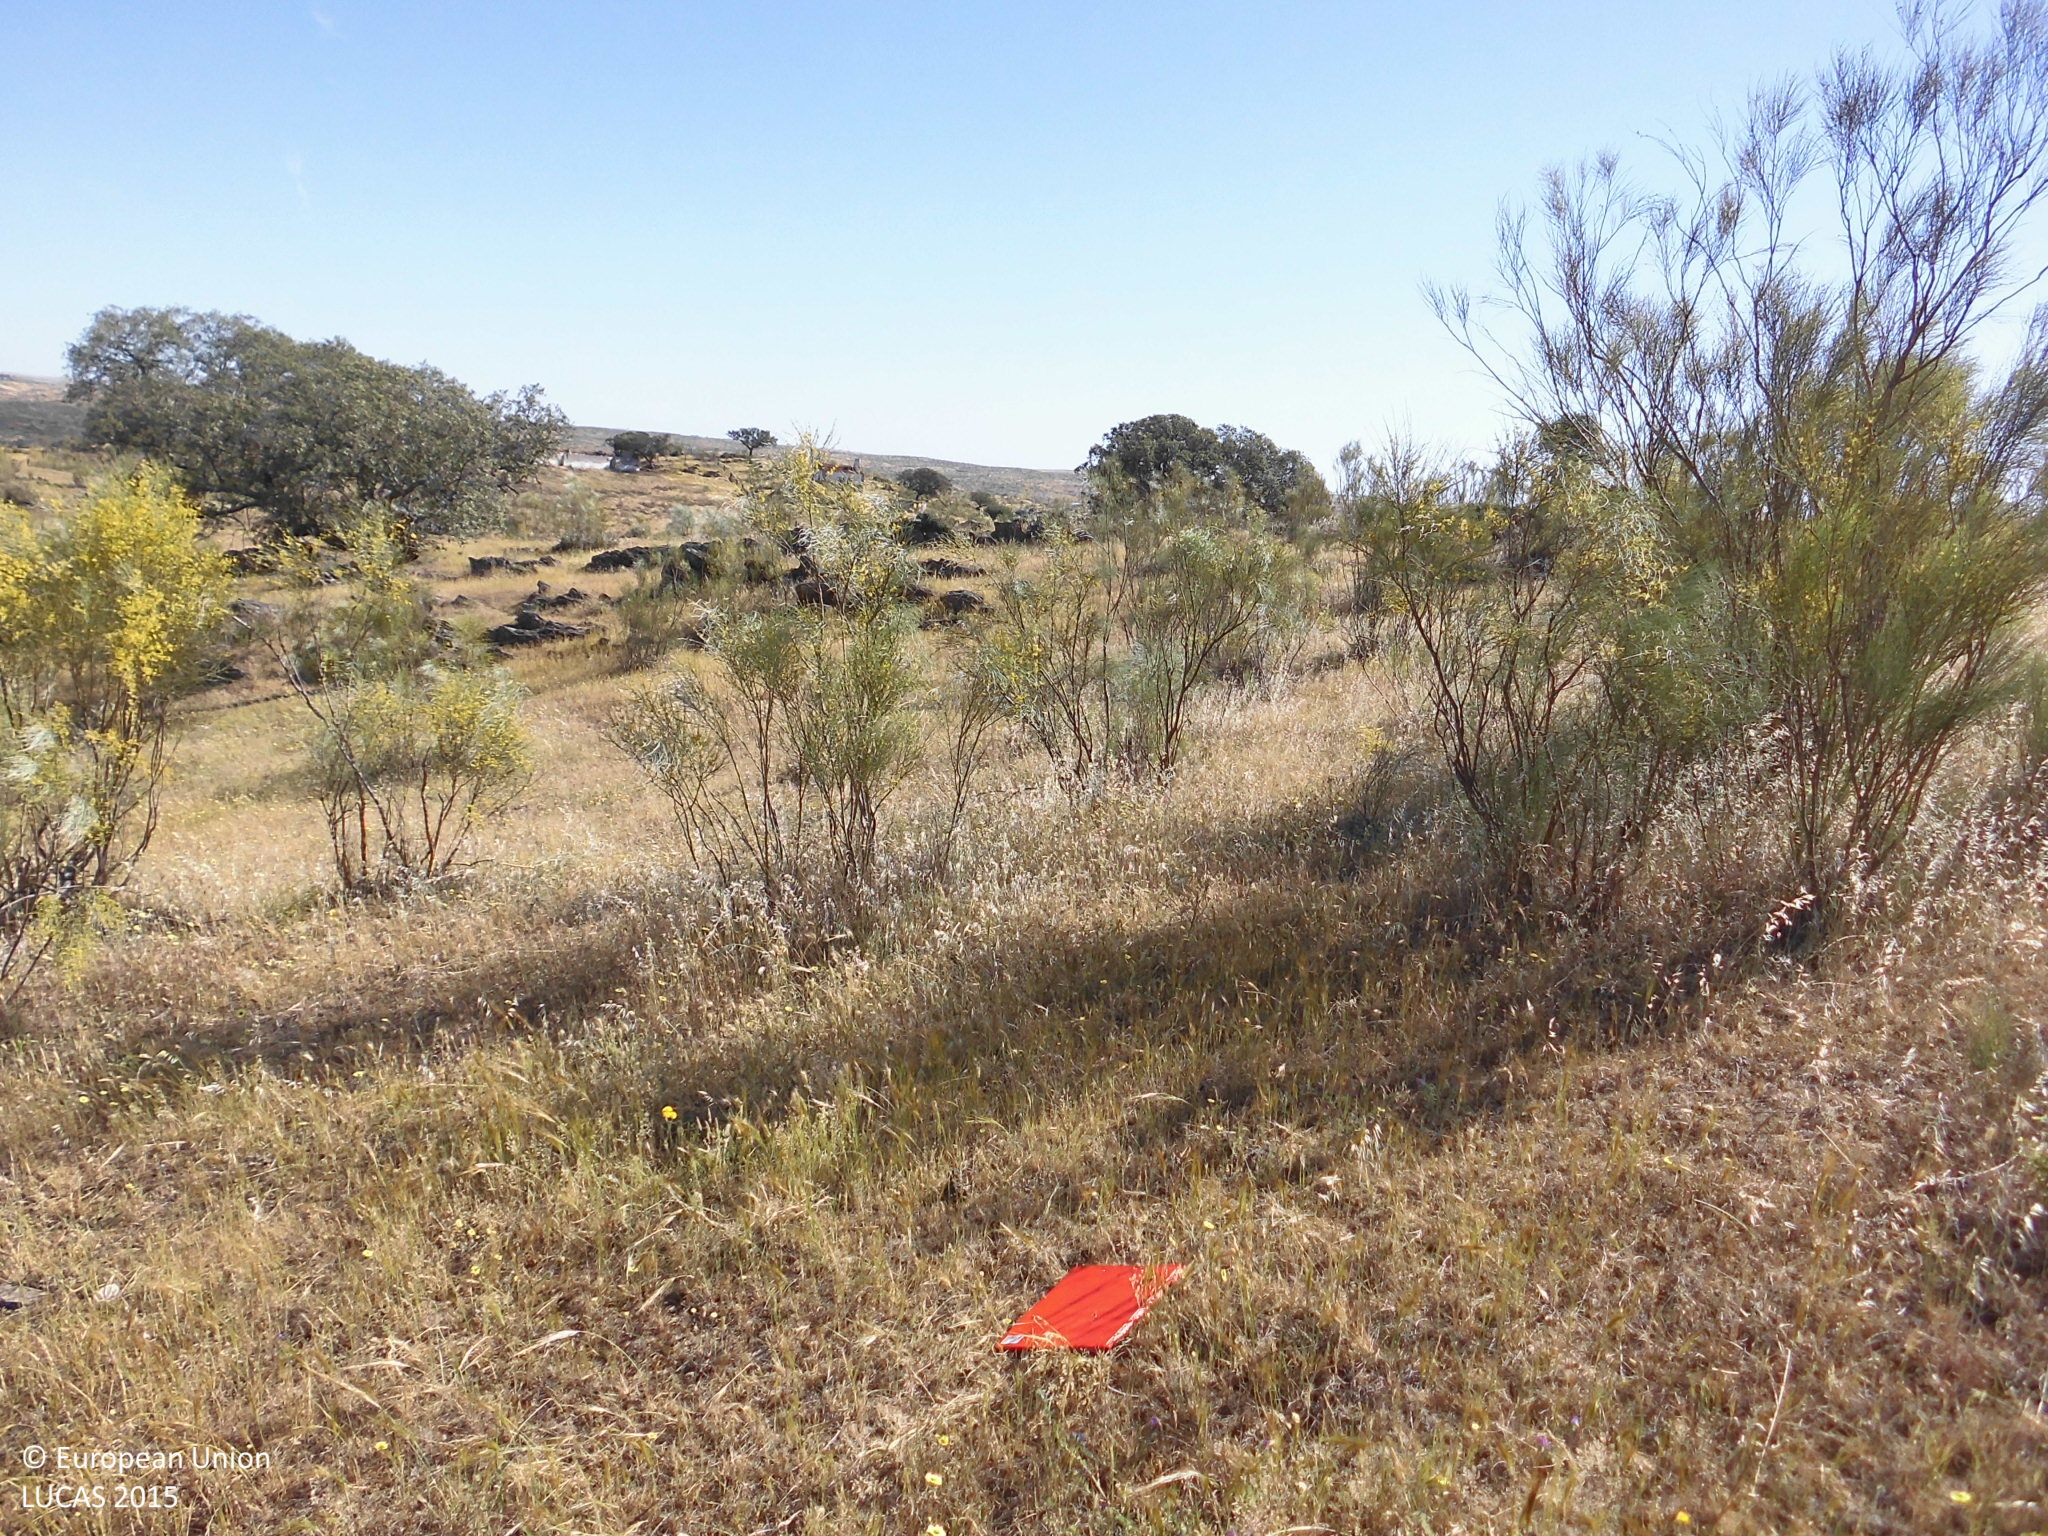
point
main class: Woodland
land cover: Broadleaved woodland
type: broadleaved evergreen forest
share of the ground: 10 - 25 %
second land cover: Grassland without tree/shrub cover
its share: > 75 %
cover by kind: herbaceous plants 65 %, broadleaved forest trees 25 %, shrubs 10 %
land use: Forestry
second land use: Agriculture (excluding fallow land and kitchen gardens)
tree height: > 5 m
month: May
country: ES
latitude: 39.5164
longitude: -6.9587
